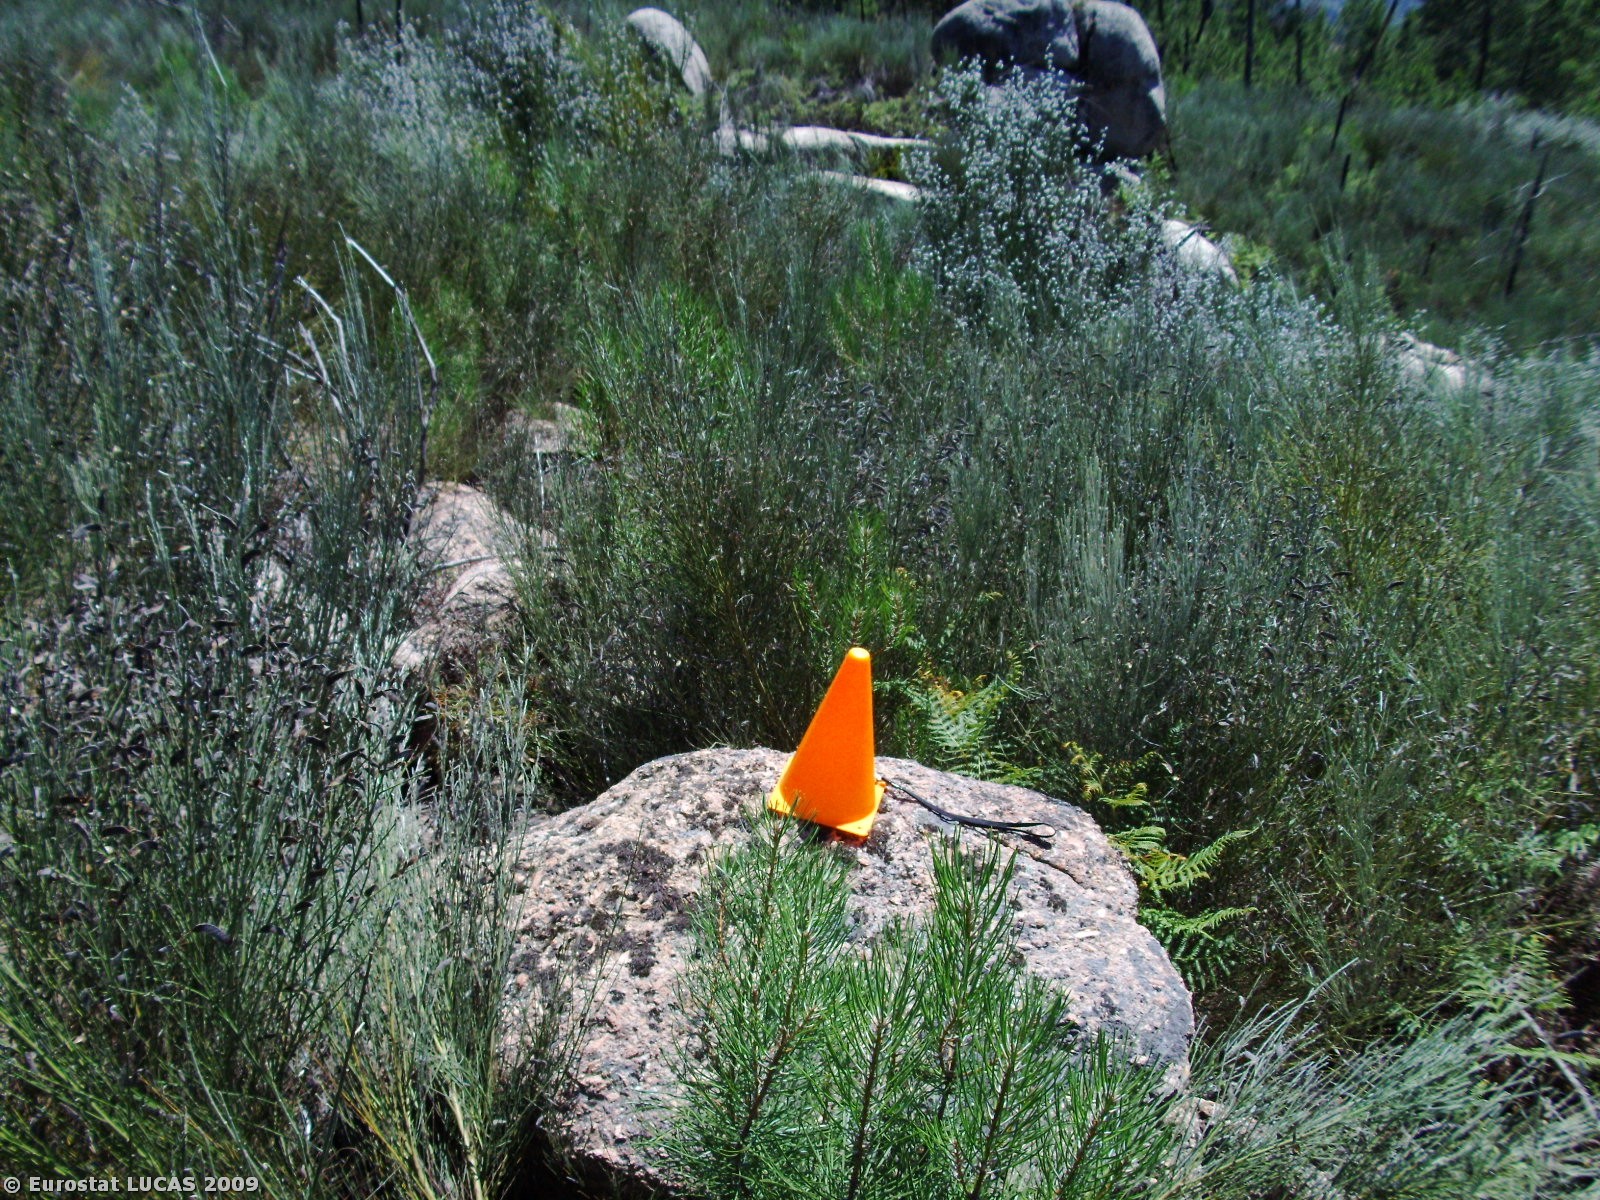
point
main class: Shrubland
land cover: Shrubland without tree cover
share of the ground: 50 - 75 %
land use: Unused
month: July
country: PT
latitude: 40.6851
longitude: -7.6414
